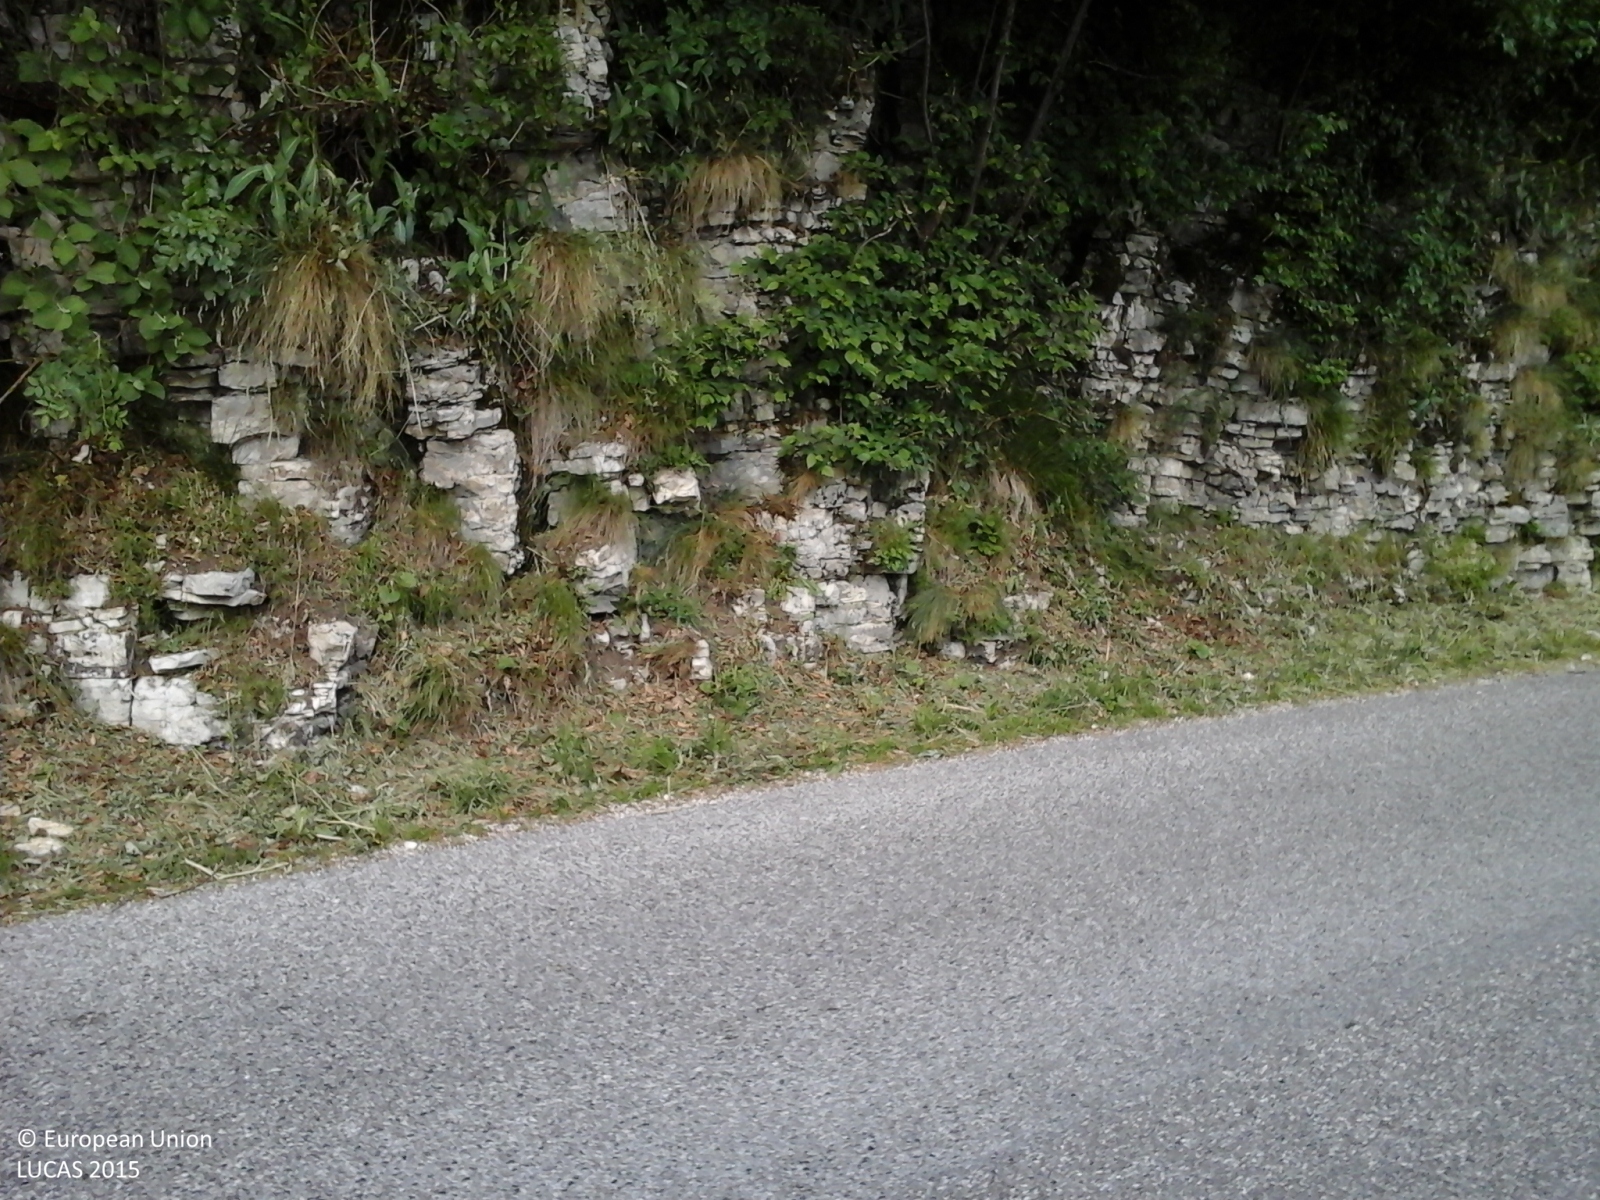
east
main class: Woodland
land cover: Broadleaved woodland
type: thermophilous deciduous forest
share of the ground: > 75 %
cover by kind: broadleaved forest trees 100 %
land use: Semi-natural and natural areas not in use
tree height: > 5 m
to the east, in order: Broadleaved woodland; Paved roads, cycling and walking lanes; Broadleaved woodland; Electric lines; Fences; Grassland without tree/shrub cover
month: June
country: IT
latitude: 45.8326
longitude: 11.7354
